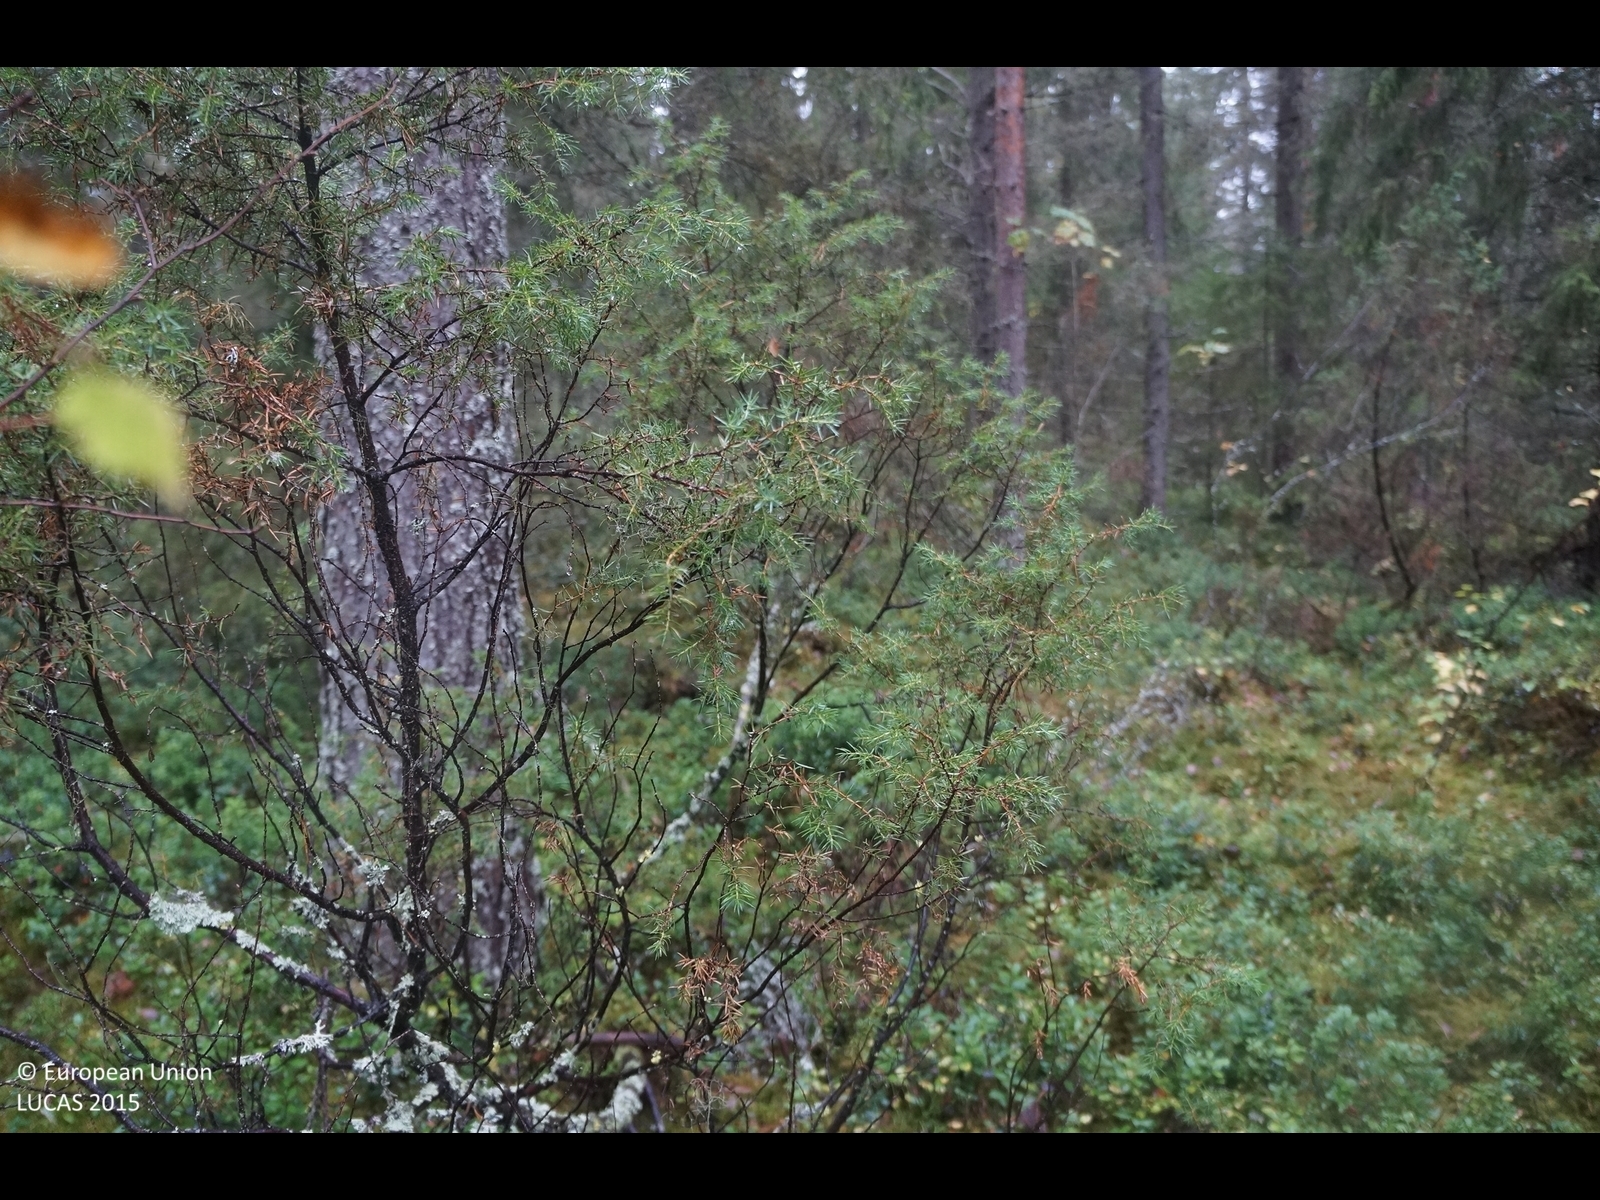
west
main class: Woodland
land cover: Spruce dominated coniferous woodland
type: boreal forest
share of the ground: 50 - 75 %
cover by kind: coniferous forest trees 60 %, shrubs 15 %, lichens and mosses 15 %, herbaceous plants 10 %
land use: Forestry
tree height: > 5 m
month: September
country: FI
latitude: 64.0574
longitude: 24.5183
